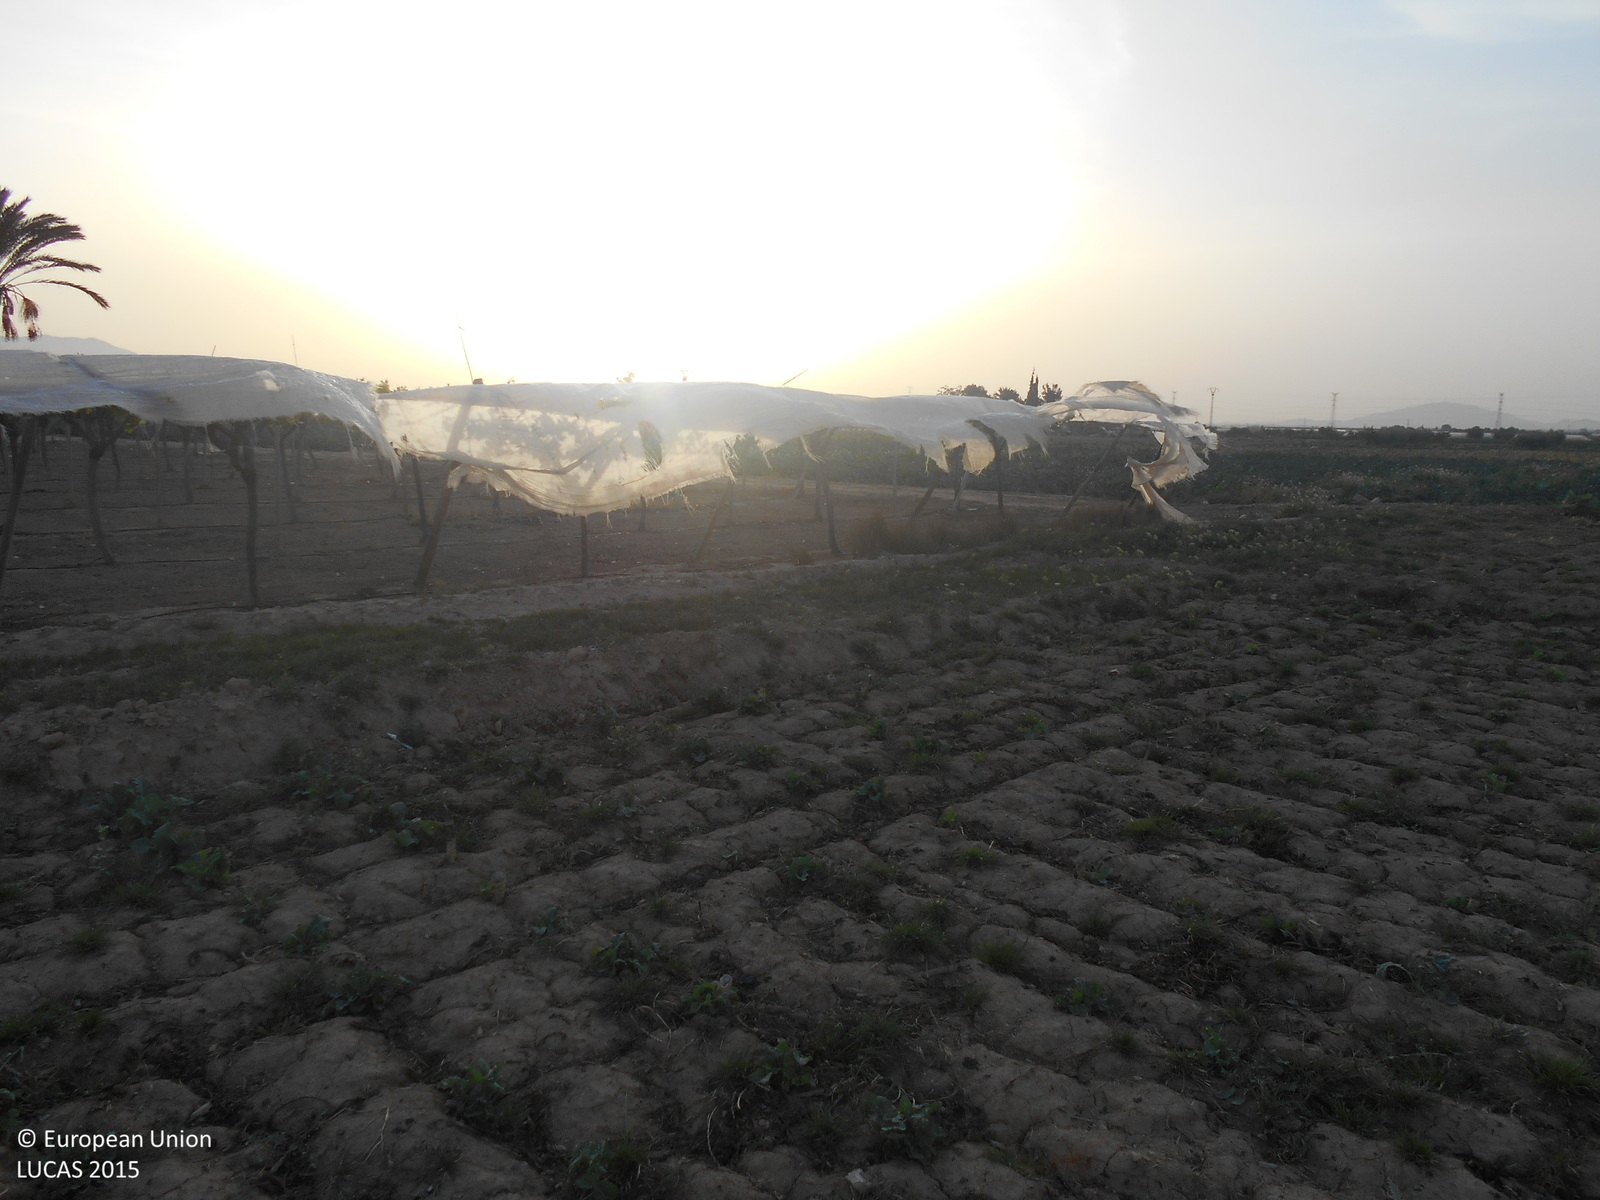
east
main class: Grassland
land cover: Spontaneously vegetated surfaces
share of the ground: 10 - 25 %
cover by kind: unconsolidated bare surface 80 %, herbaceous plants 20 %
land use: Fallow land
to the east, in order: Spontaneously vegetated surfaces; Ditches and canals; Vineyards; Tracks; Ditches and canals; Other fresh vegetables; Grass margins; Other fresh vegetables; Grass margins; Other fresh vegetables; Tracks; Ditches and canals; Spontaneously vegetated surfaces; Tracks; Other bare soil; Groves; Ditches and canals; Tracks; Other bare soil
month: April
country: ES
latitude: 37.7426
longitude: -1.5011
